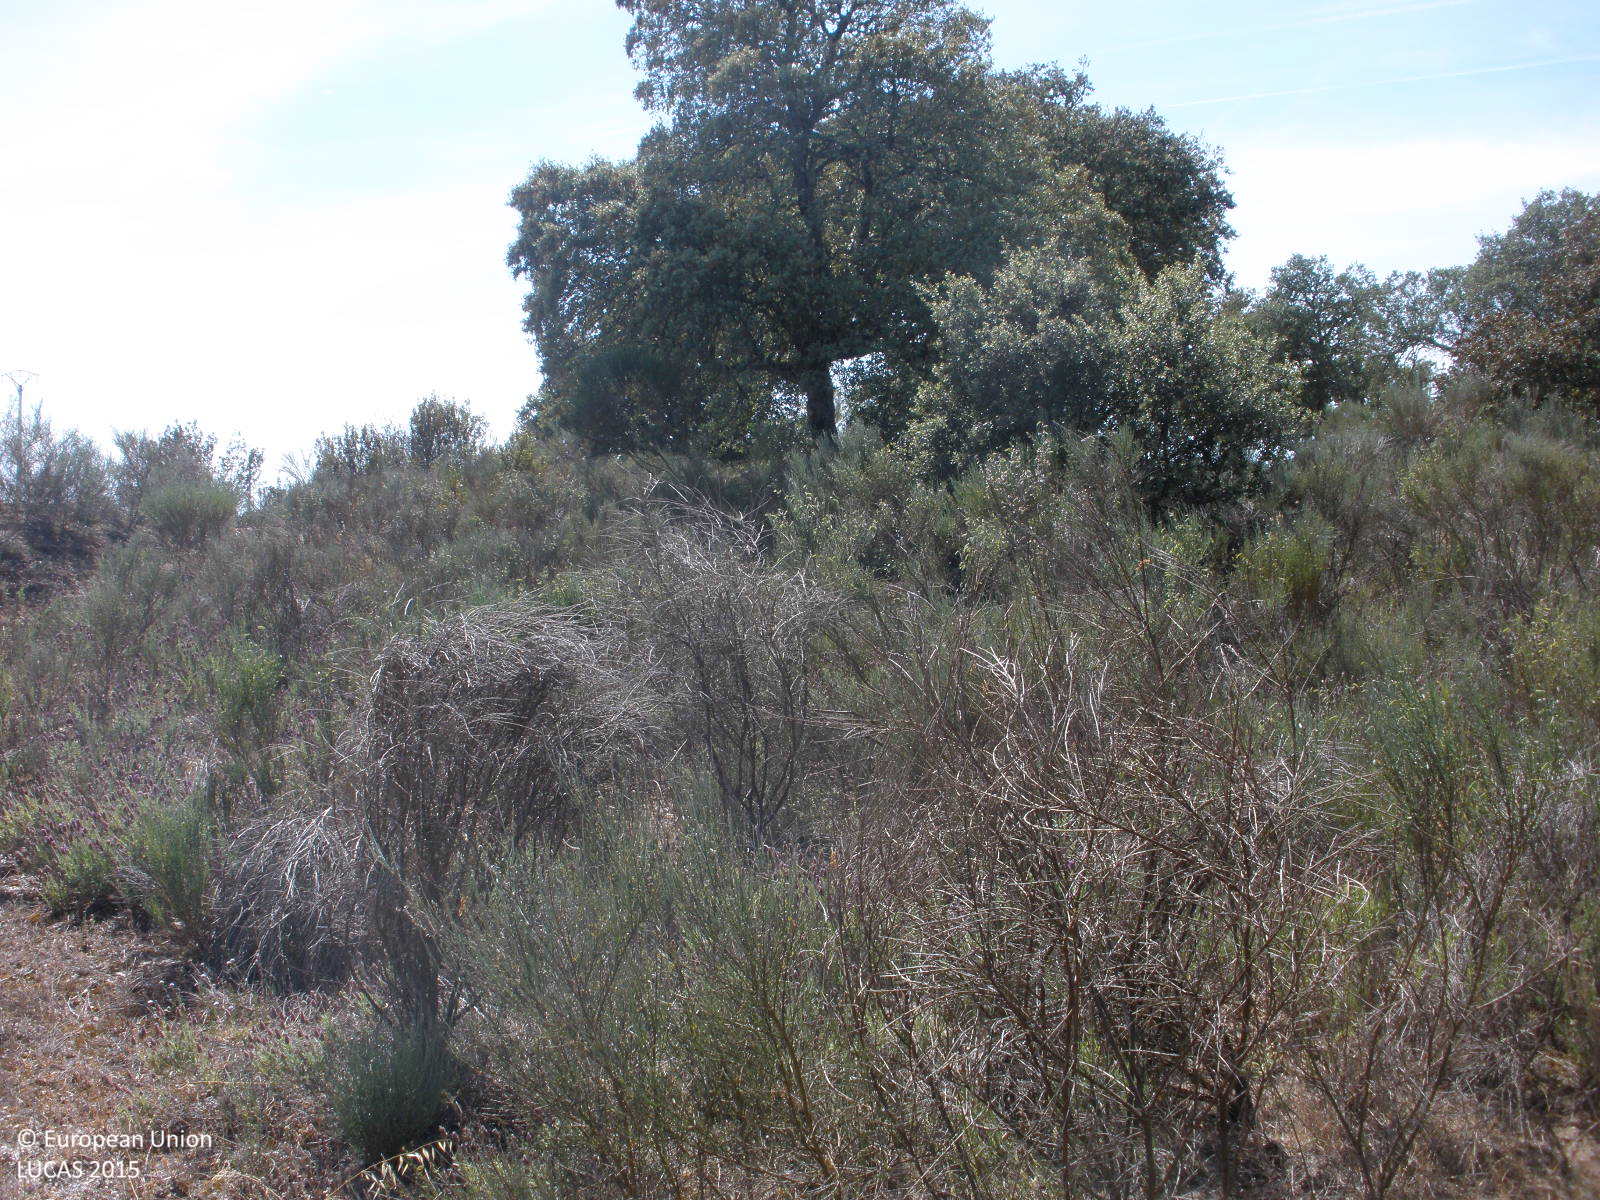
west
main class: Woodland
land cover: Broadleaved woodland
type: broadleaved evergreen forest
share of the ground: > 75 %
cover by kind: shrubs 50 %, broadleaved forest trees 40 %, herbaceous plants 10 %
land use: Semi-natural and natural areas not in use
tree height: > 5 m
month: June
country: ES
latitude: 40.5941
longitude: -6.6952
